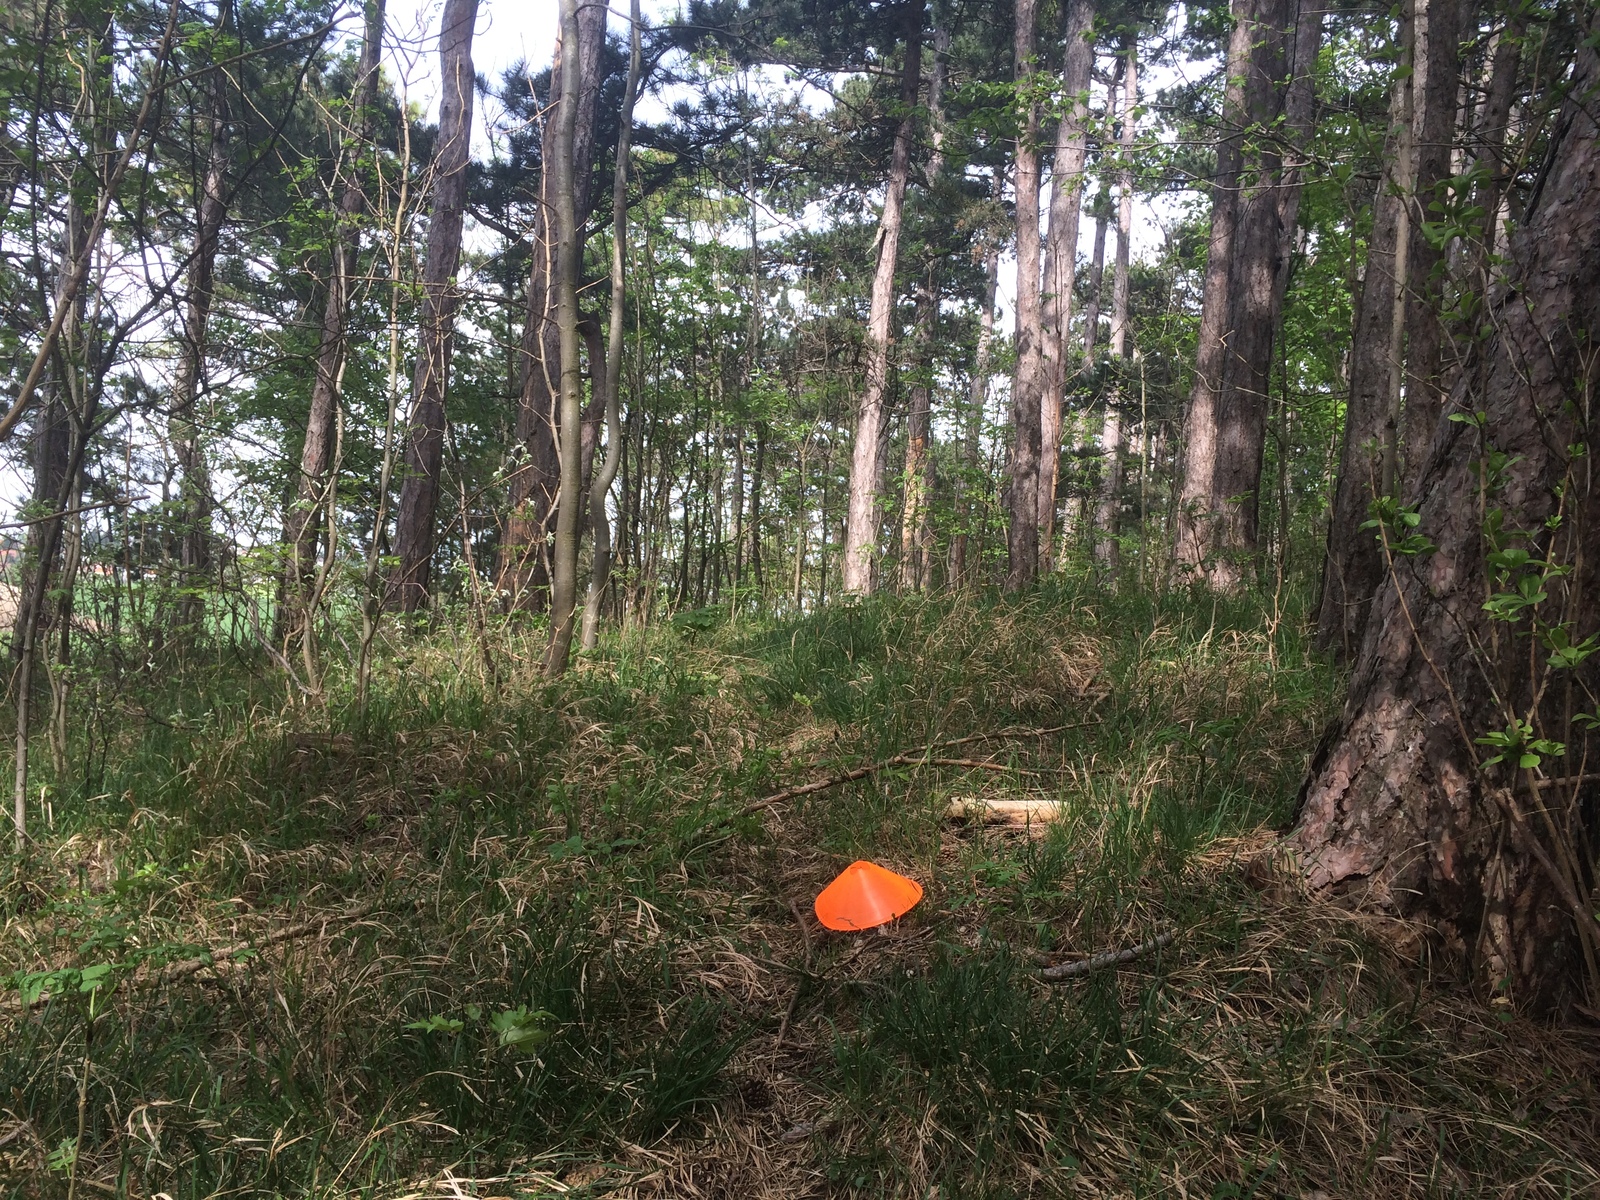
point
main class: Woodland
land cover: Pine dominated mixed woodland
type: hemiboreal forest and nemoral coniferous forest and mixed broadleaved-coniferous forest
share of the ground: > 75 %
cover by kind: coniferous forest trees 65 %, broadleaved forest trees 25 %, herbaceous plants 10 %
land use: Forestry
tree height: > 5 m
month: May
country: AT
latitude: 47.8913
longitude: 16.1156
